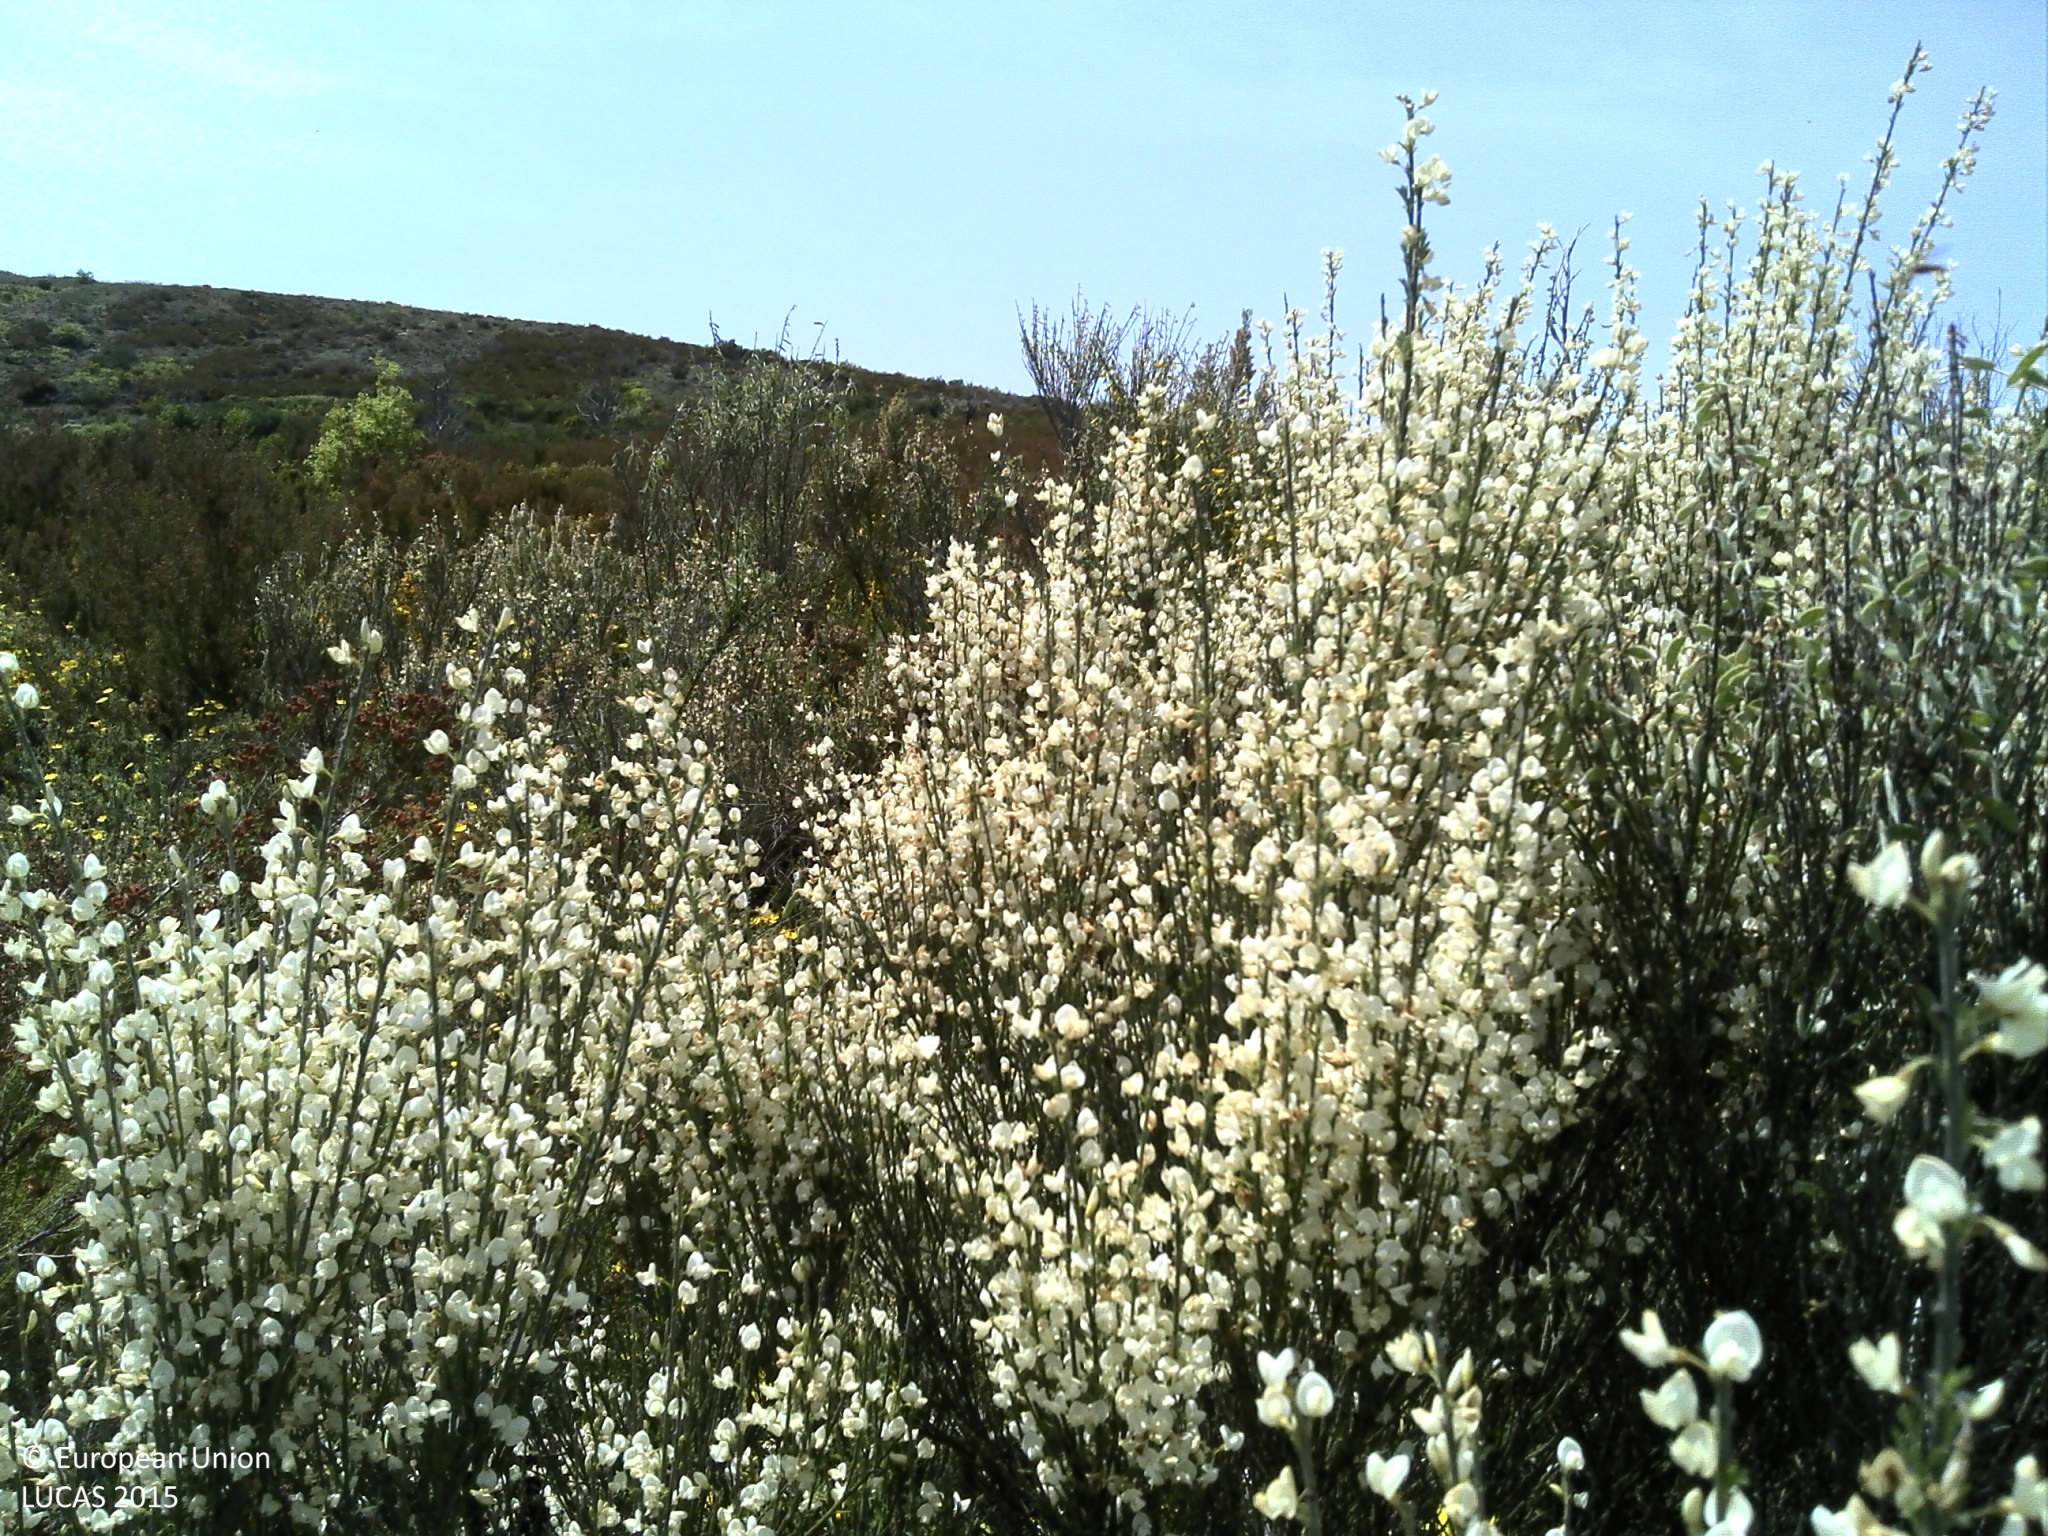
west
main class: Shrubland
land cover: Shrubland with sparse tree cover
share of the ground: > 75 %
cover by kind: shrubs 85 %, herbaceous plants 10 %, broadleaved forest trees 5 %
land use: Forestry
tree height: < 5 m
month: May
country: PT
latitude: 41.9338
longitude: -7.0426
